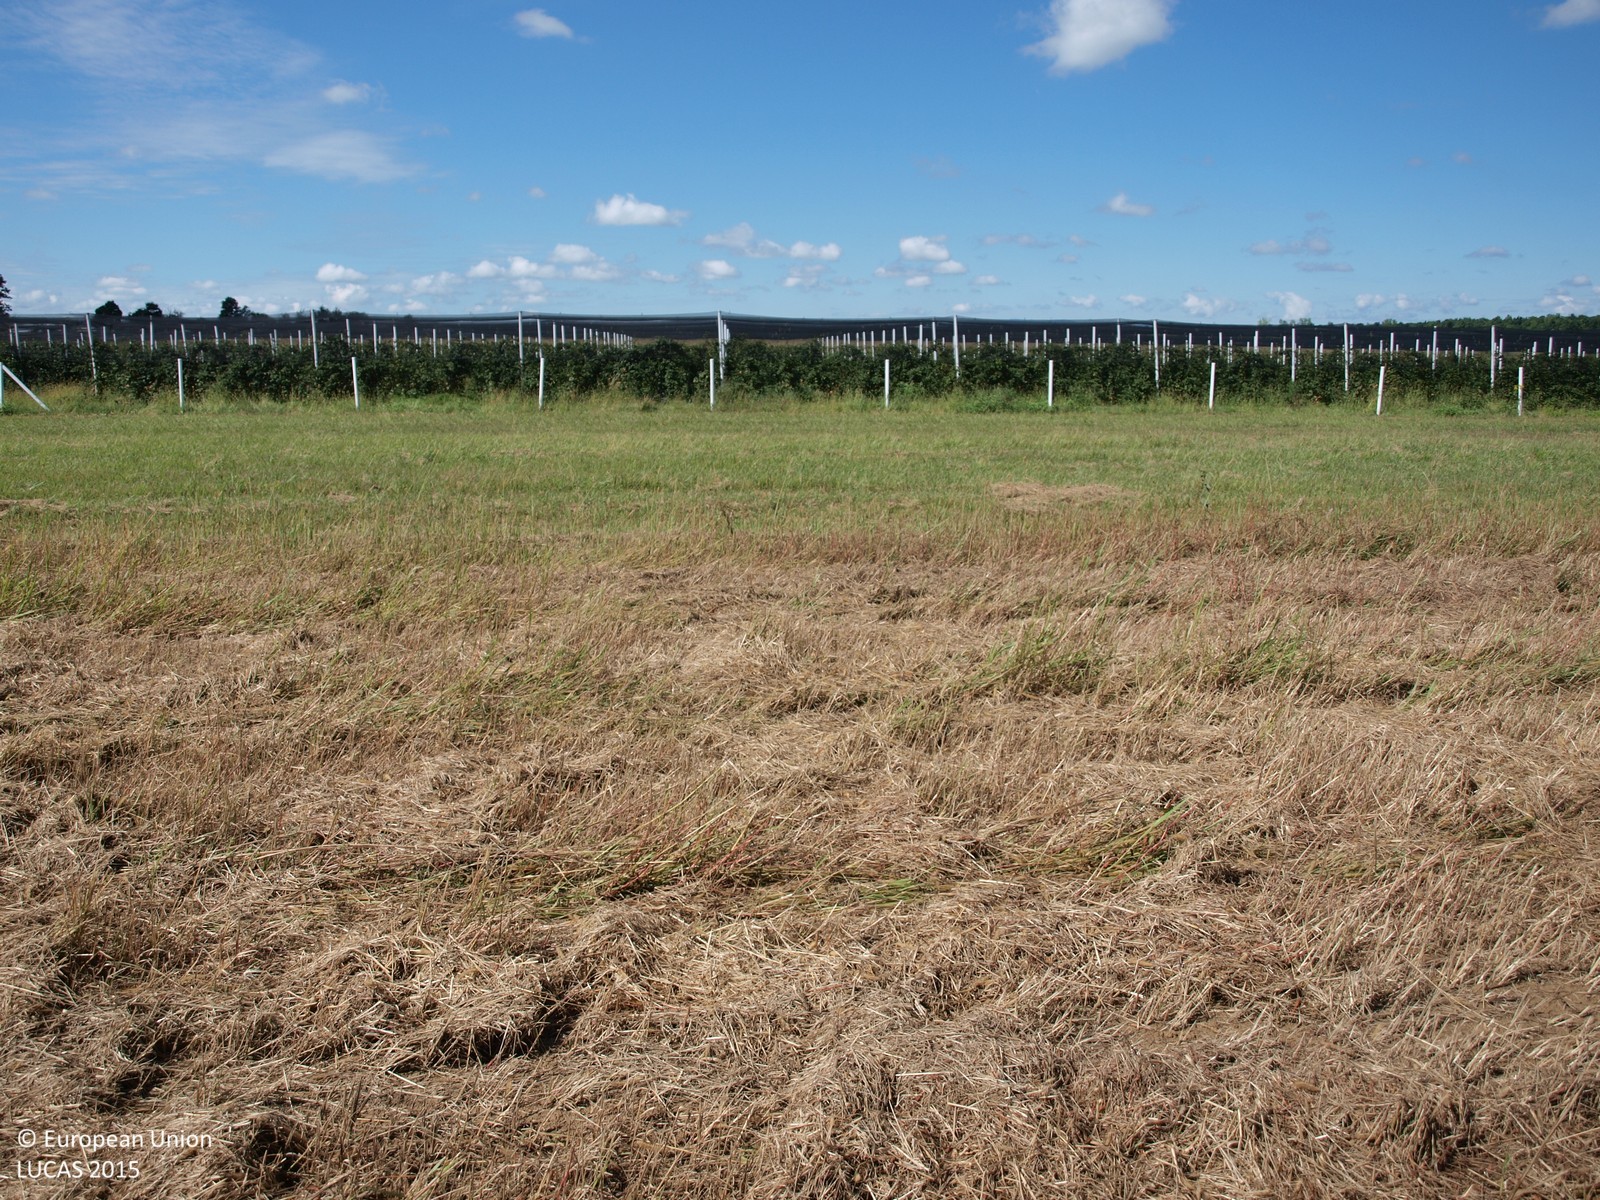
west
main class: Grassland
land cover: Grassland without tree/shrub cover
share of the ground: > 75 %
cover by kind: herbaceous plants 100 %
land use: Agriculture (excluding fallow land and kitchen gardens)
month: September
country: HR
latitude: 45.7791
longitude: 16.4166
